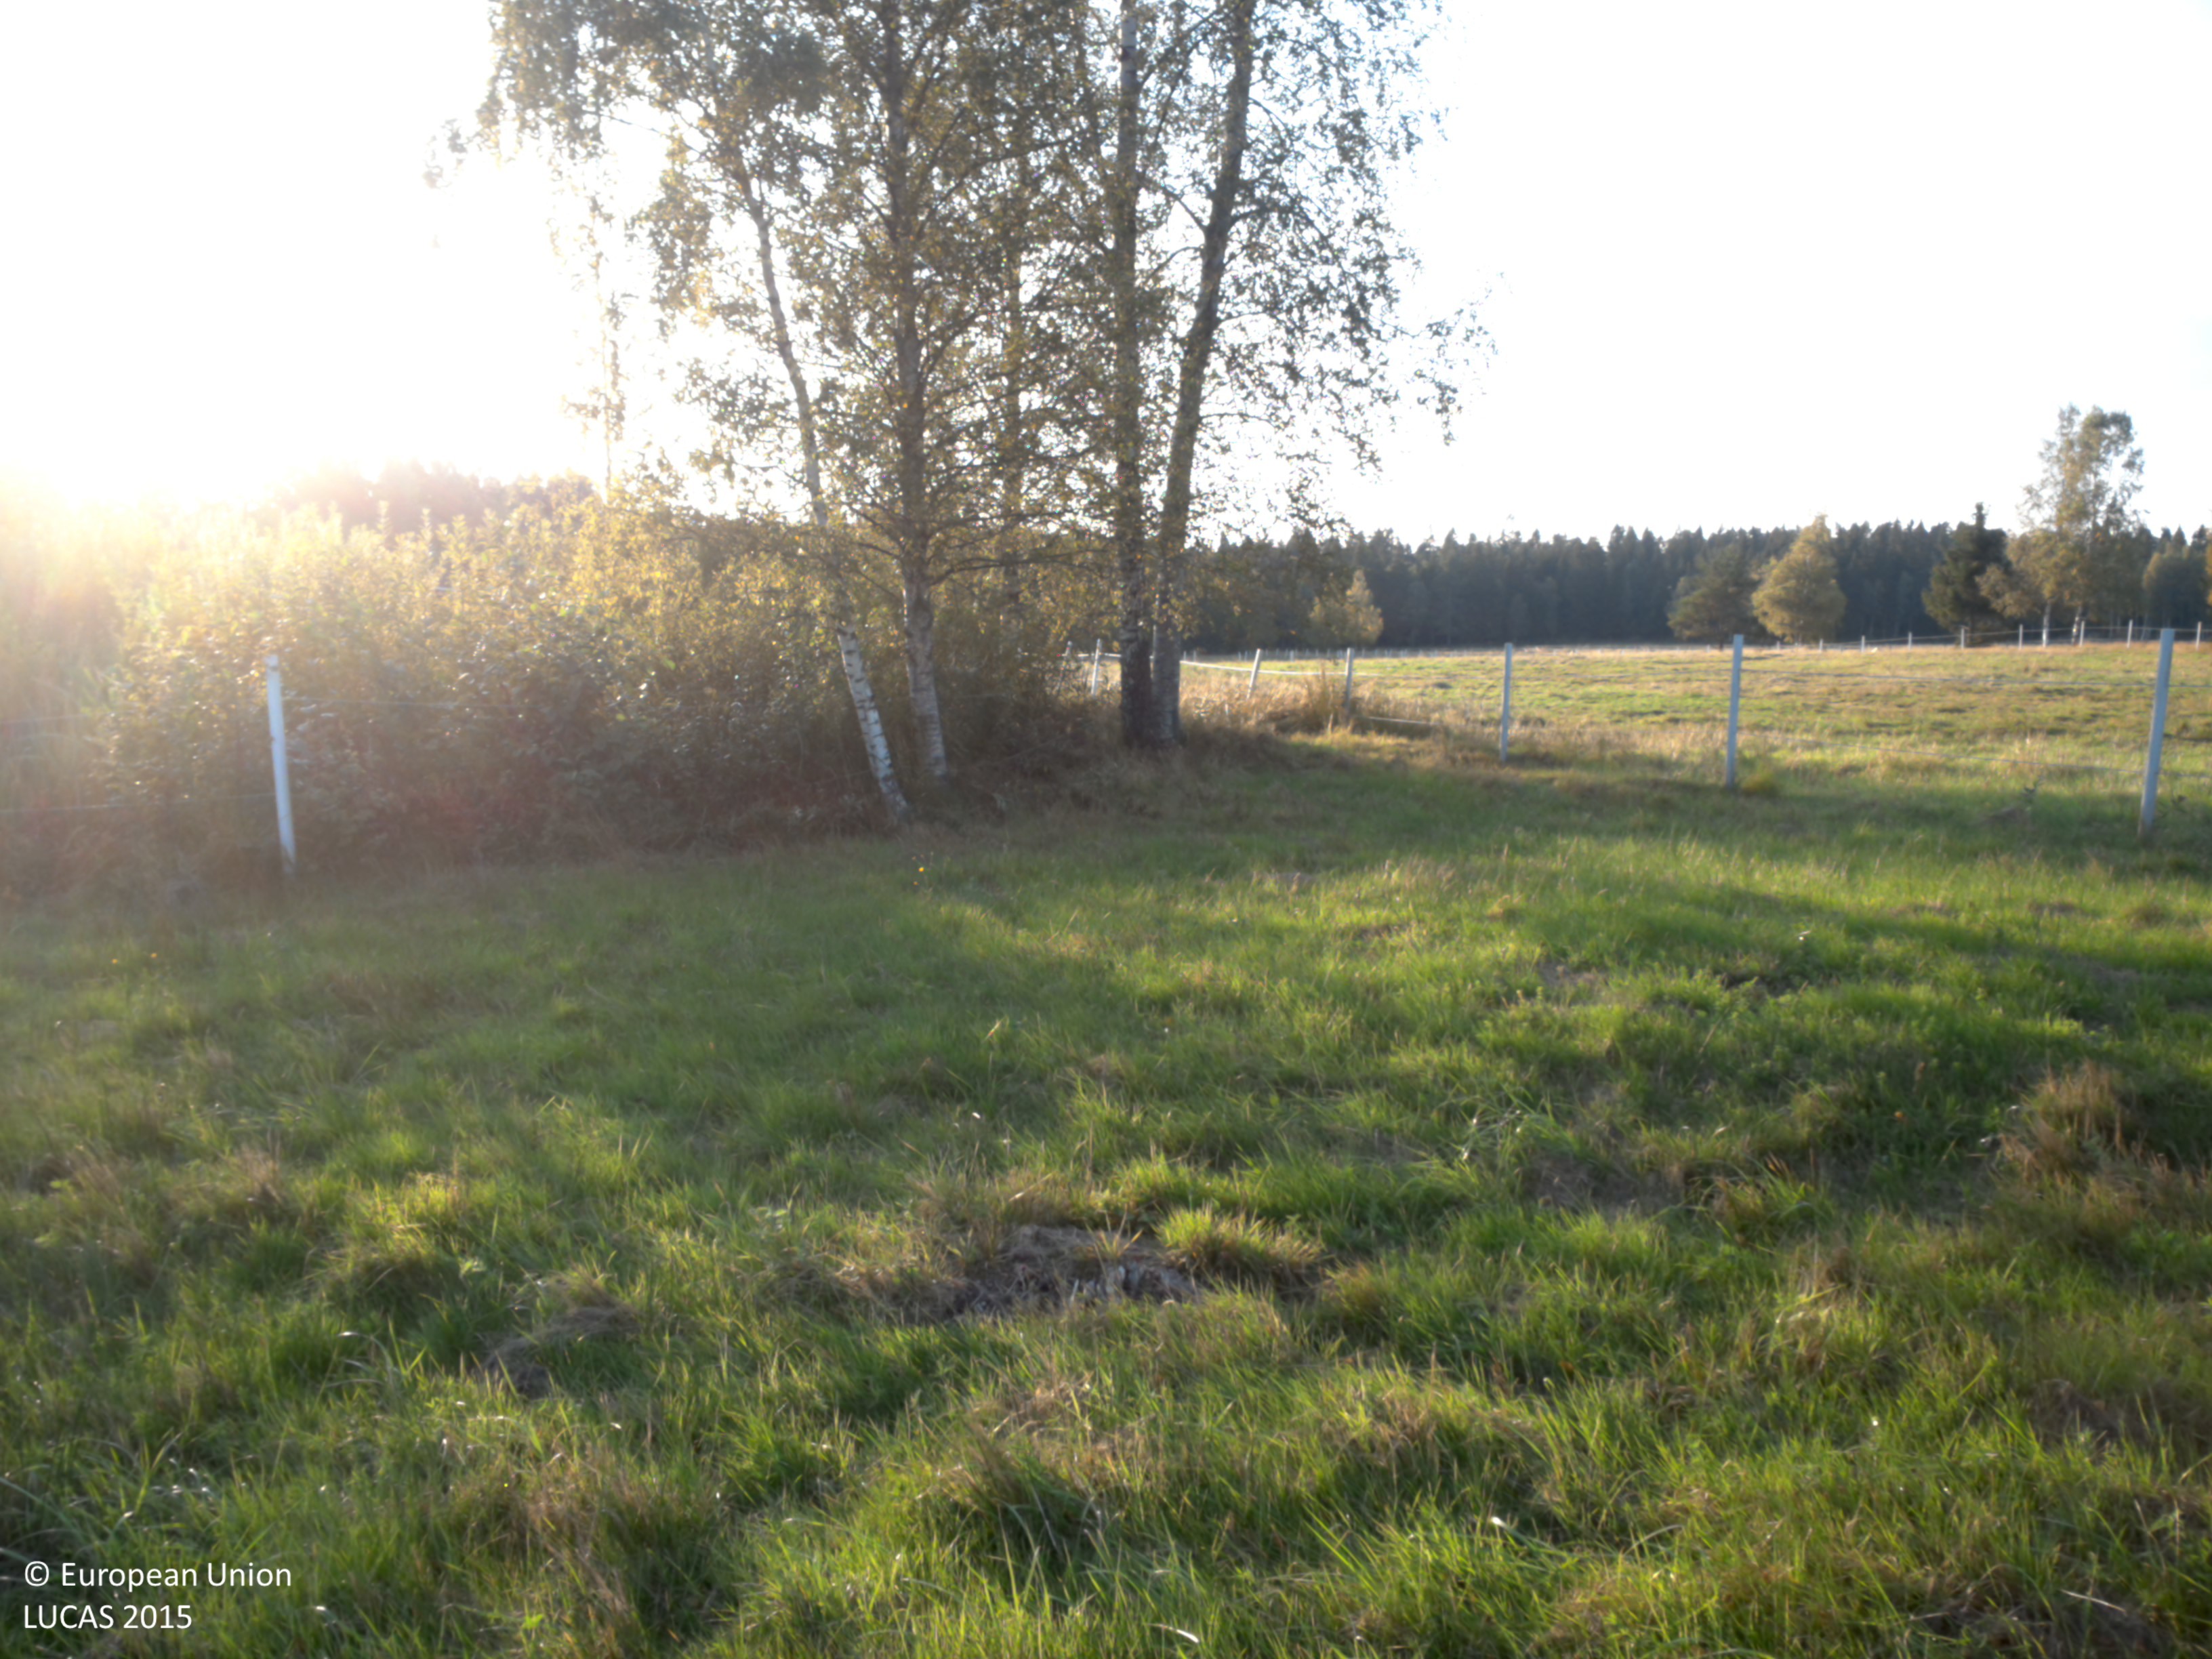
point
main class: Grassland
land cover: Grassland without tree/shrub cover
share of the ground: > 75 %
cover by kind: herbaceous plants 100 %
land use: Agriculture (excluding fallow land and kitchen gardens)
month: August
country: SE
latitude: 58.4707
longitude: 12.2415
